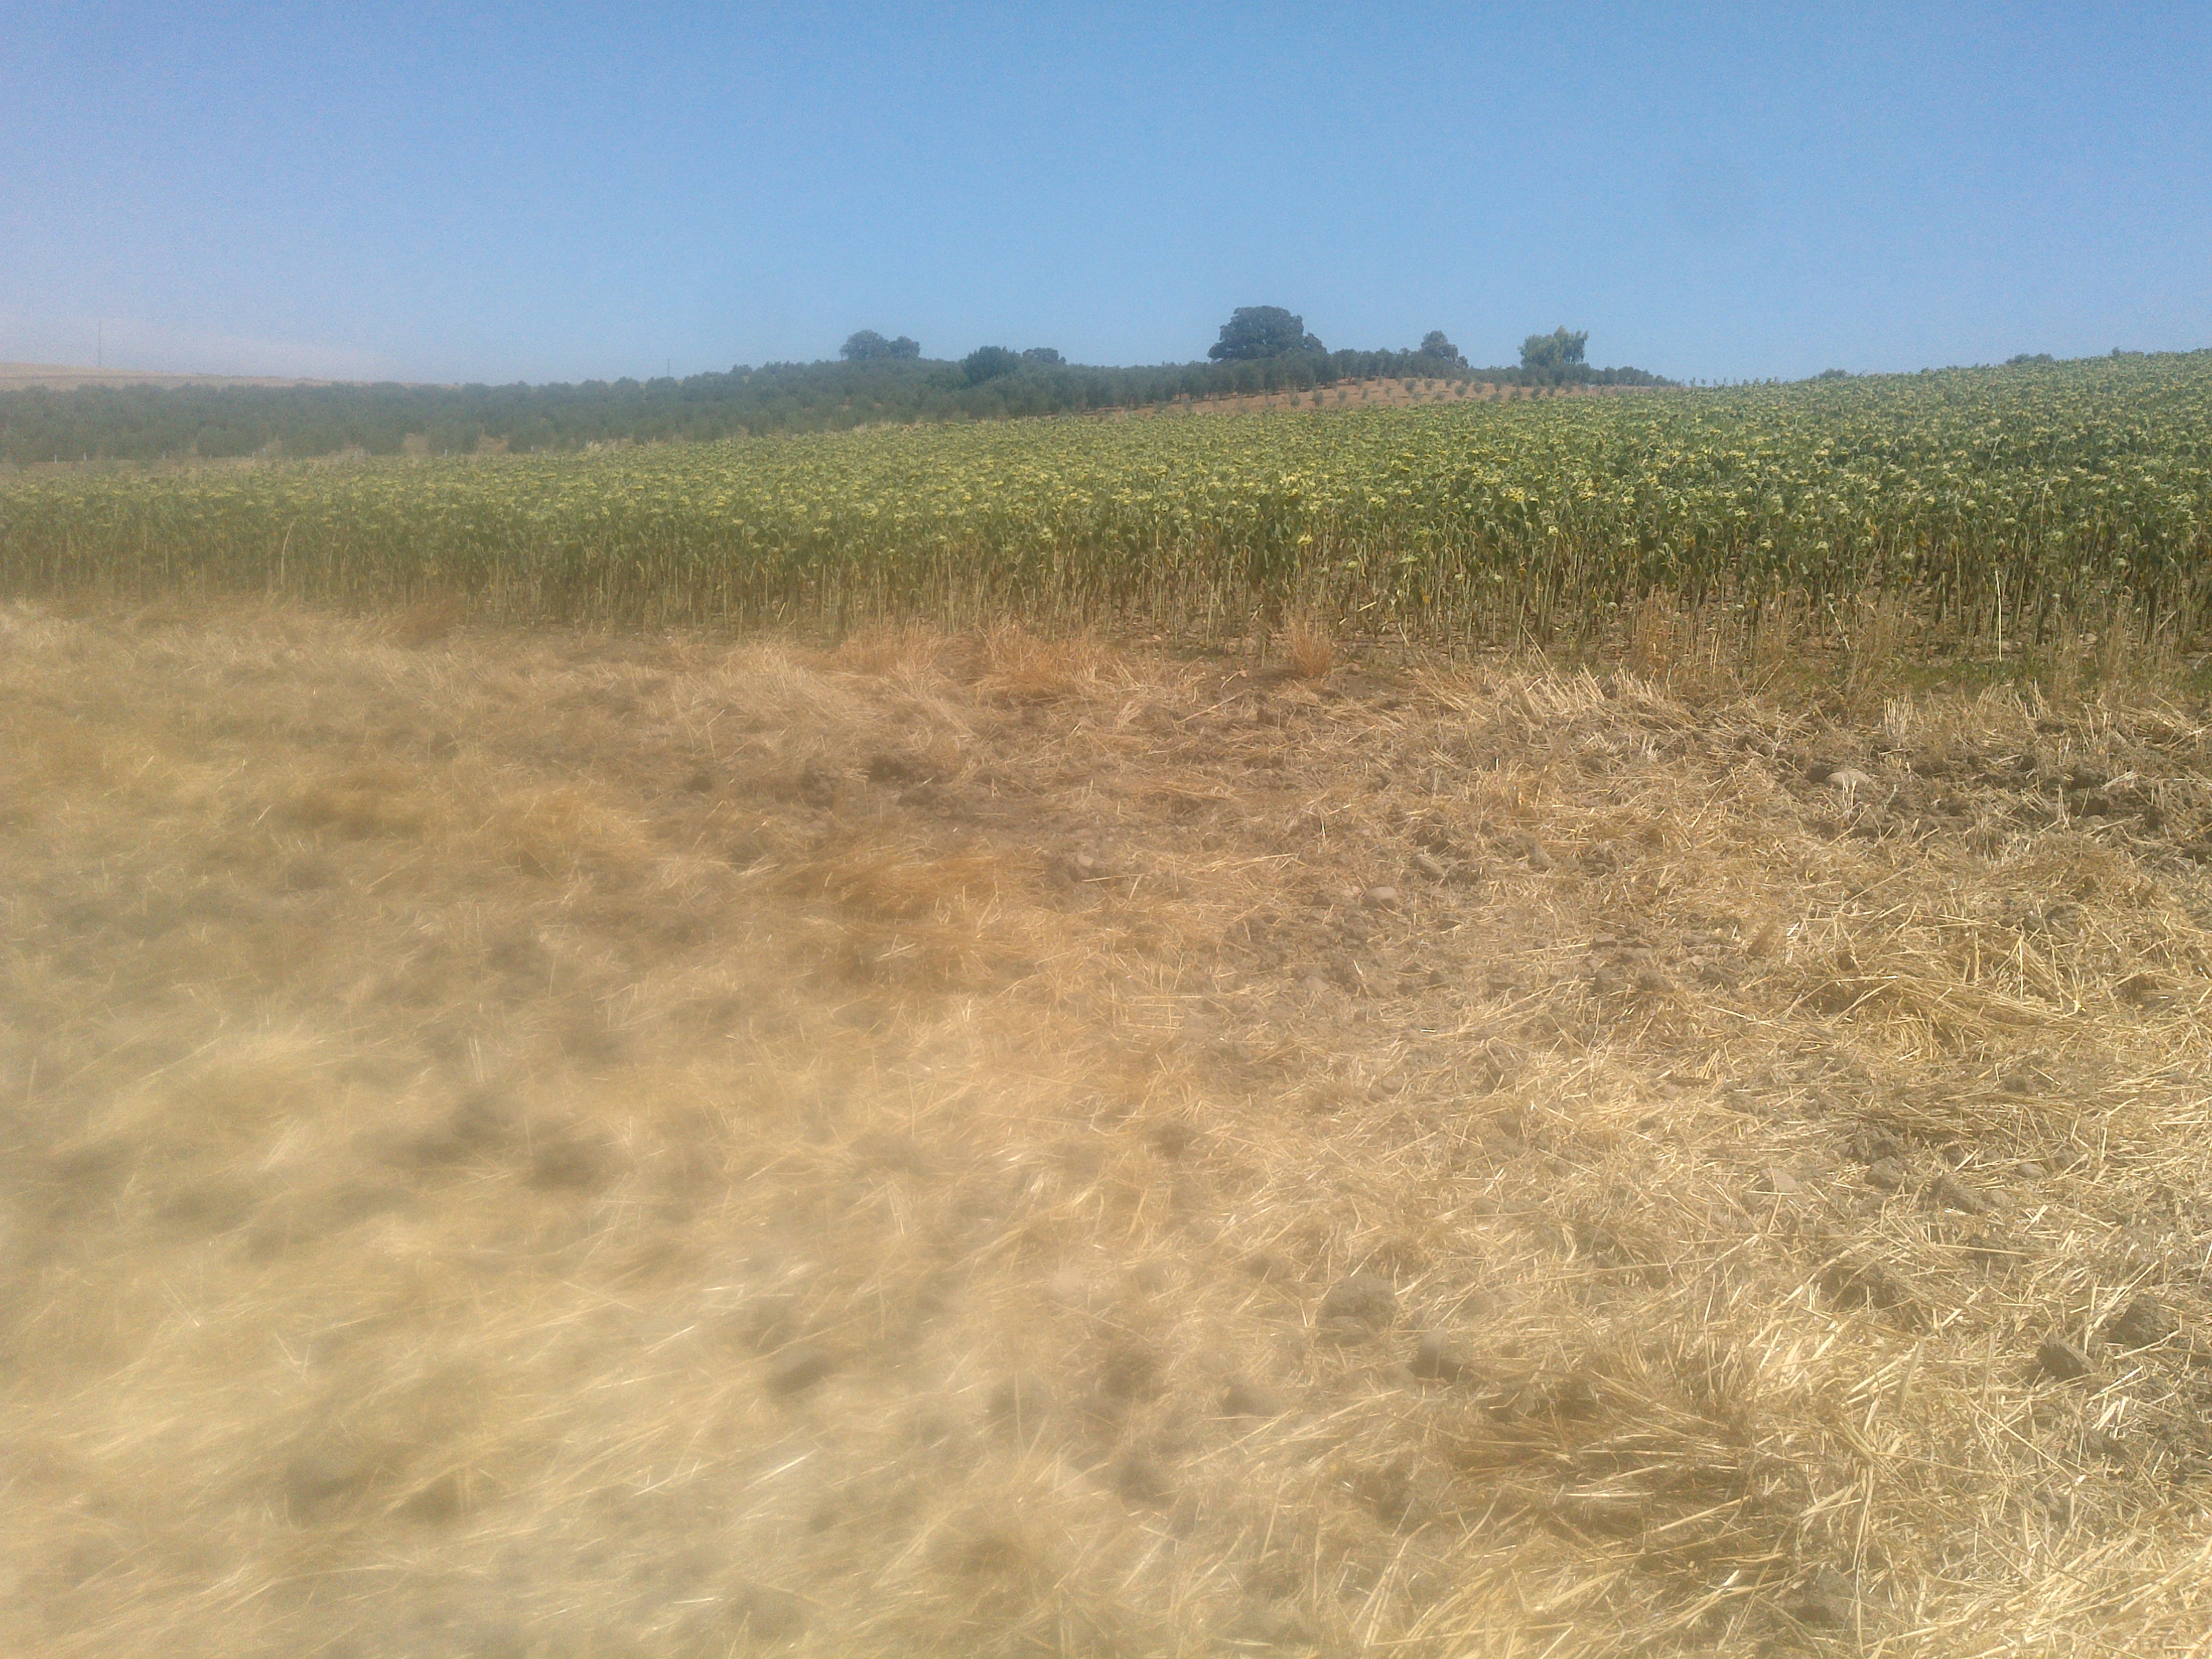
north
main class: Cropland
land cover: Durum wheat
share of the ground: < 10 %
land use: Agriculture (excluding fallow land and kitchen gardens)
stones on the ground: 10 - 25 %
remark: Harvested field
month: June
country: ES
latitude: 37.6708
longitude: -4.8984
